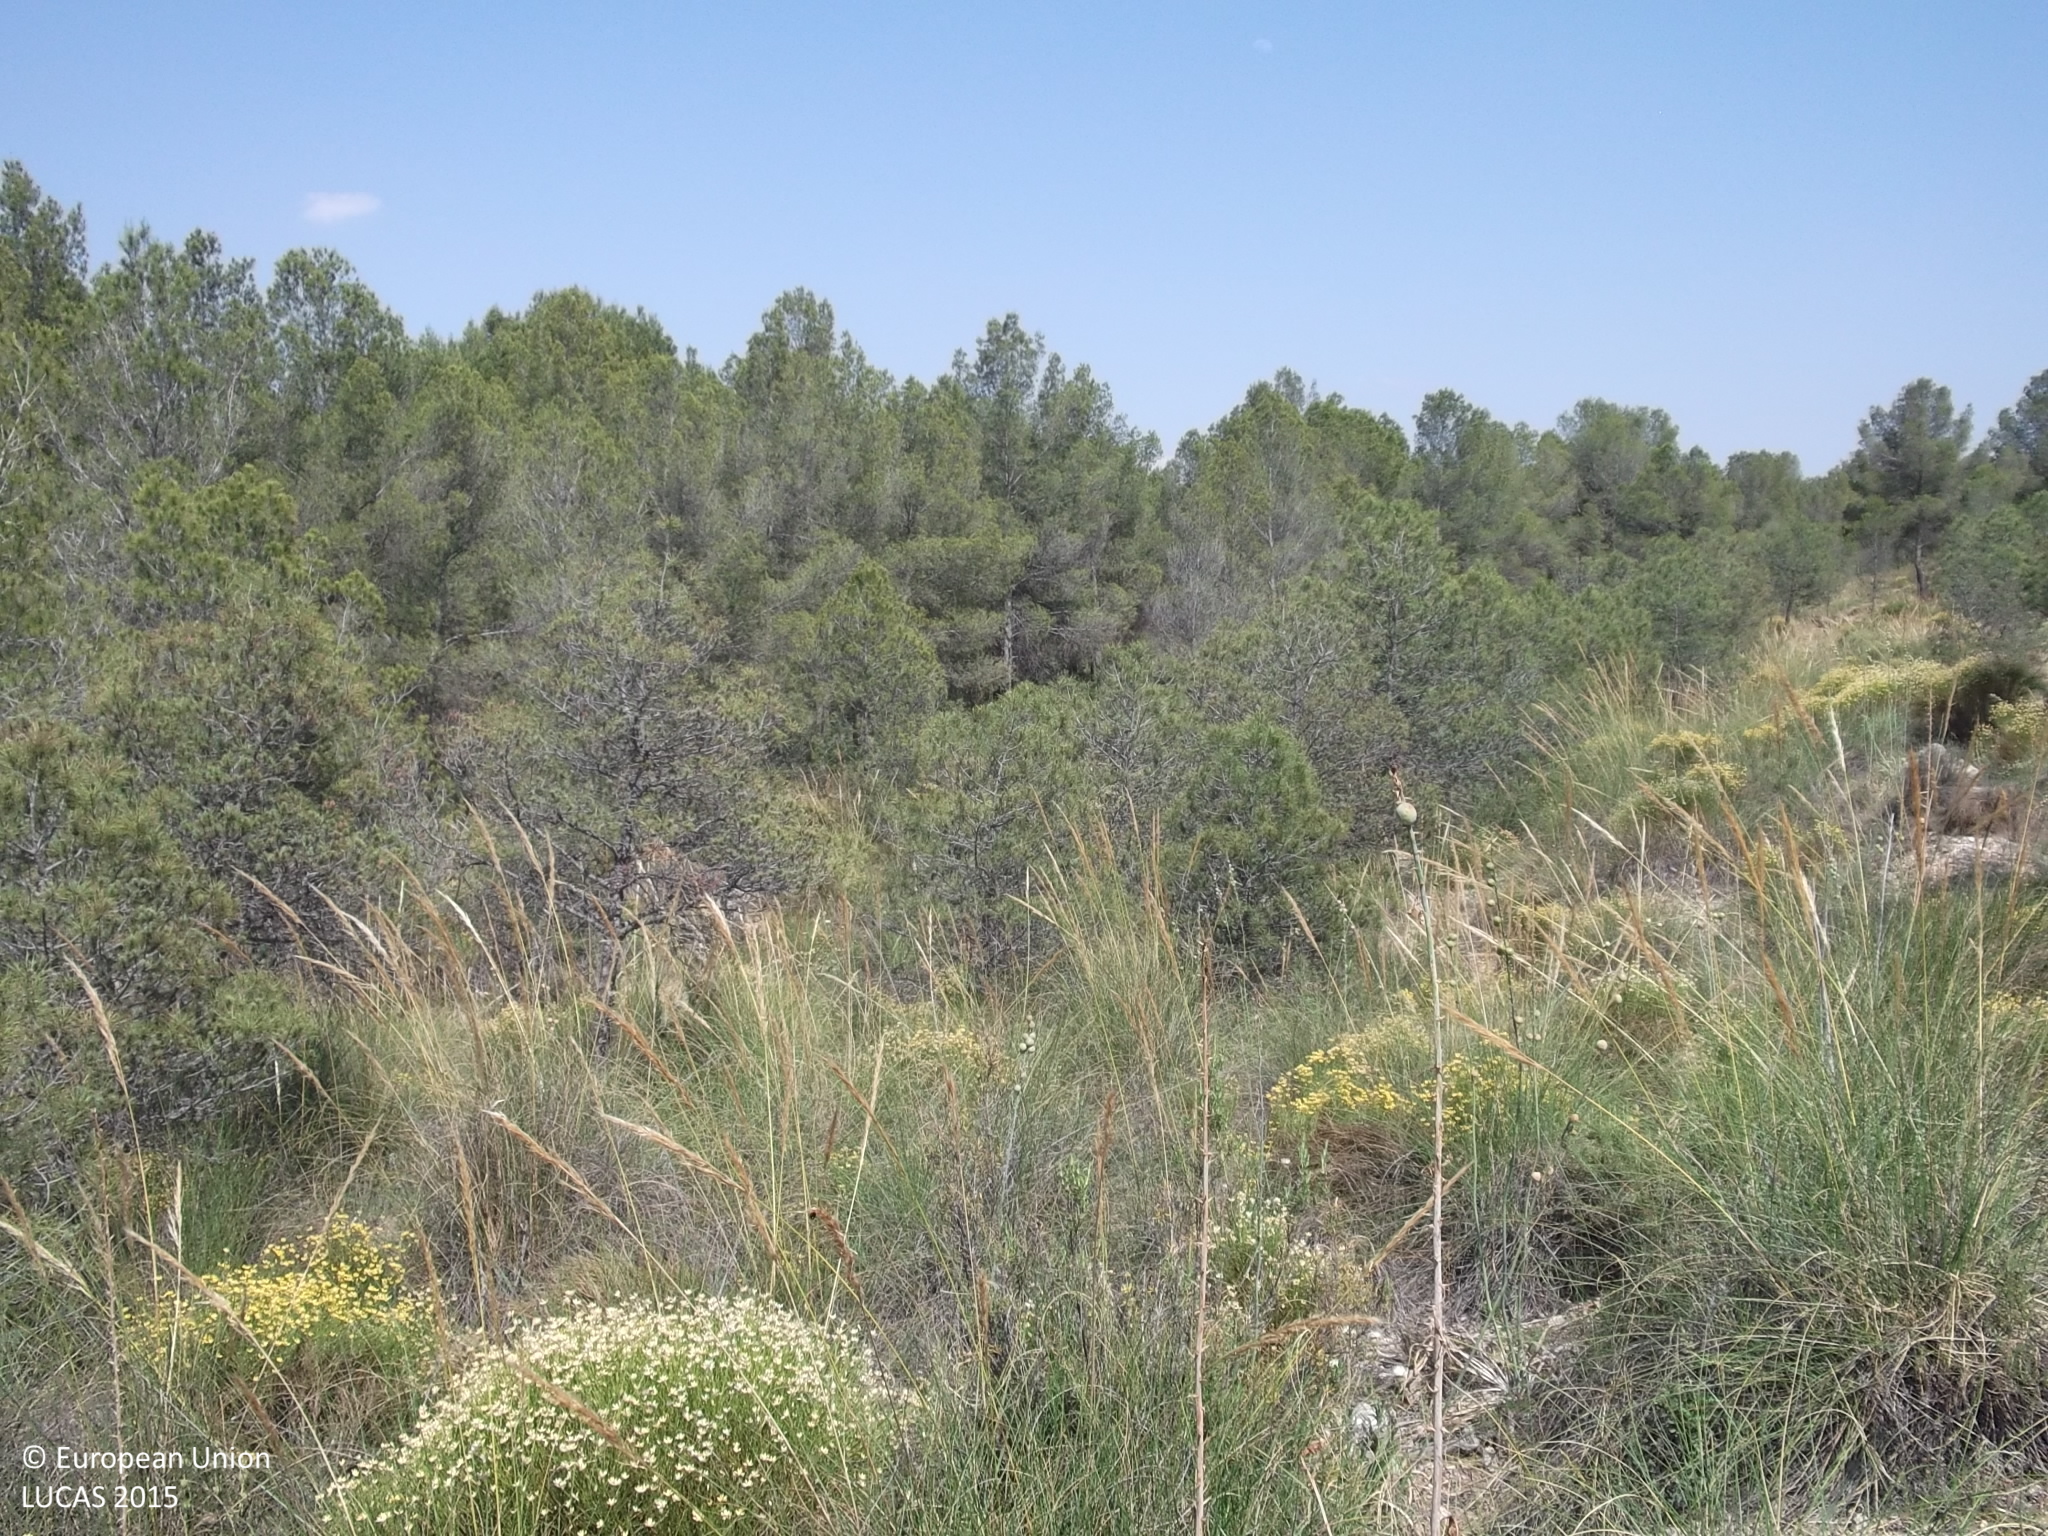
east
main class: Woodland
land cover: Pine dominated coniferous woodland
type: coniferous forest of the mediterranean region
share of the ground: 10 - 25 %
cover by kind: shrubs 30 %, herbaceous plants 30 %, coniferous forest trees 20 %, consolidated bare surface 20 %
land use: Semi-natural and natural areas not in use
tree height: < 5 m
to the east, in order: Pine dominated coniferous woodland; Tracks; Pine dominated coniferous woodland; Tracks; Olive groves
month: May
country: ES
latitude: 38.4000
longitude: -1.6598
